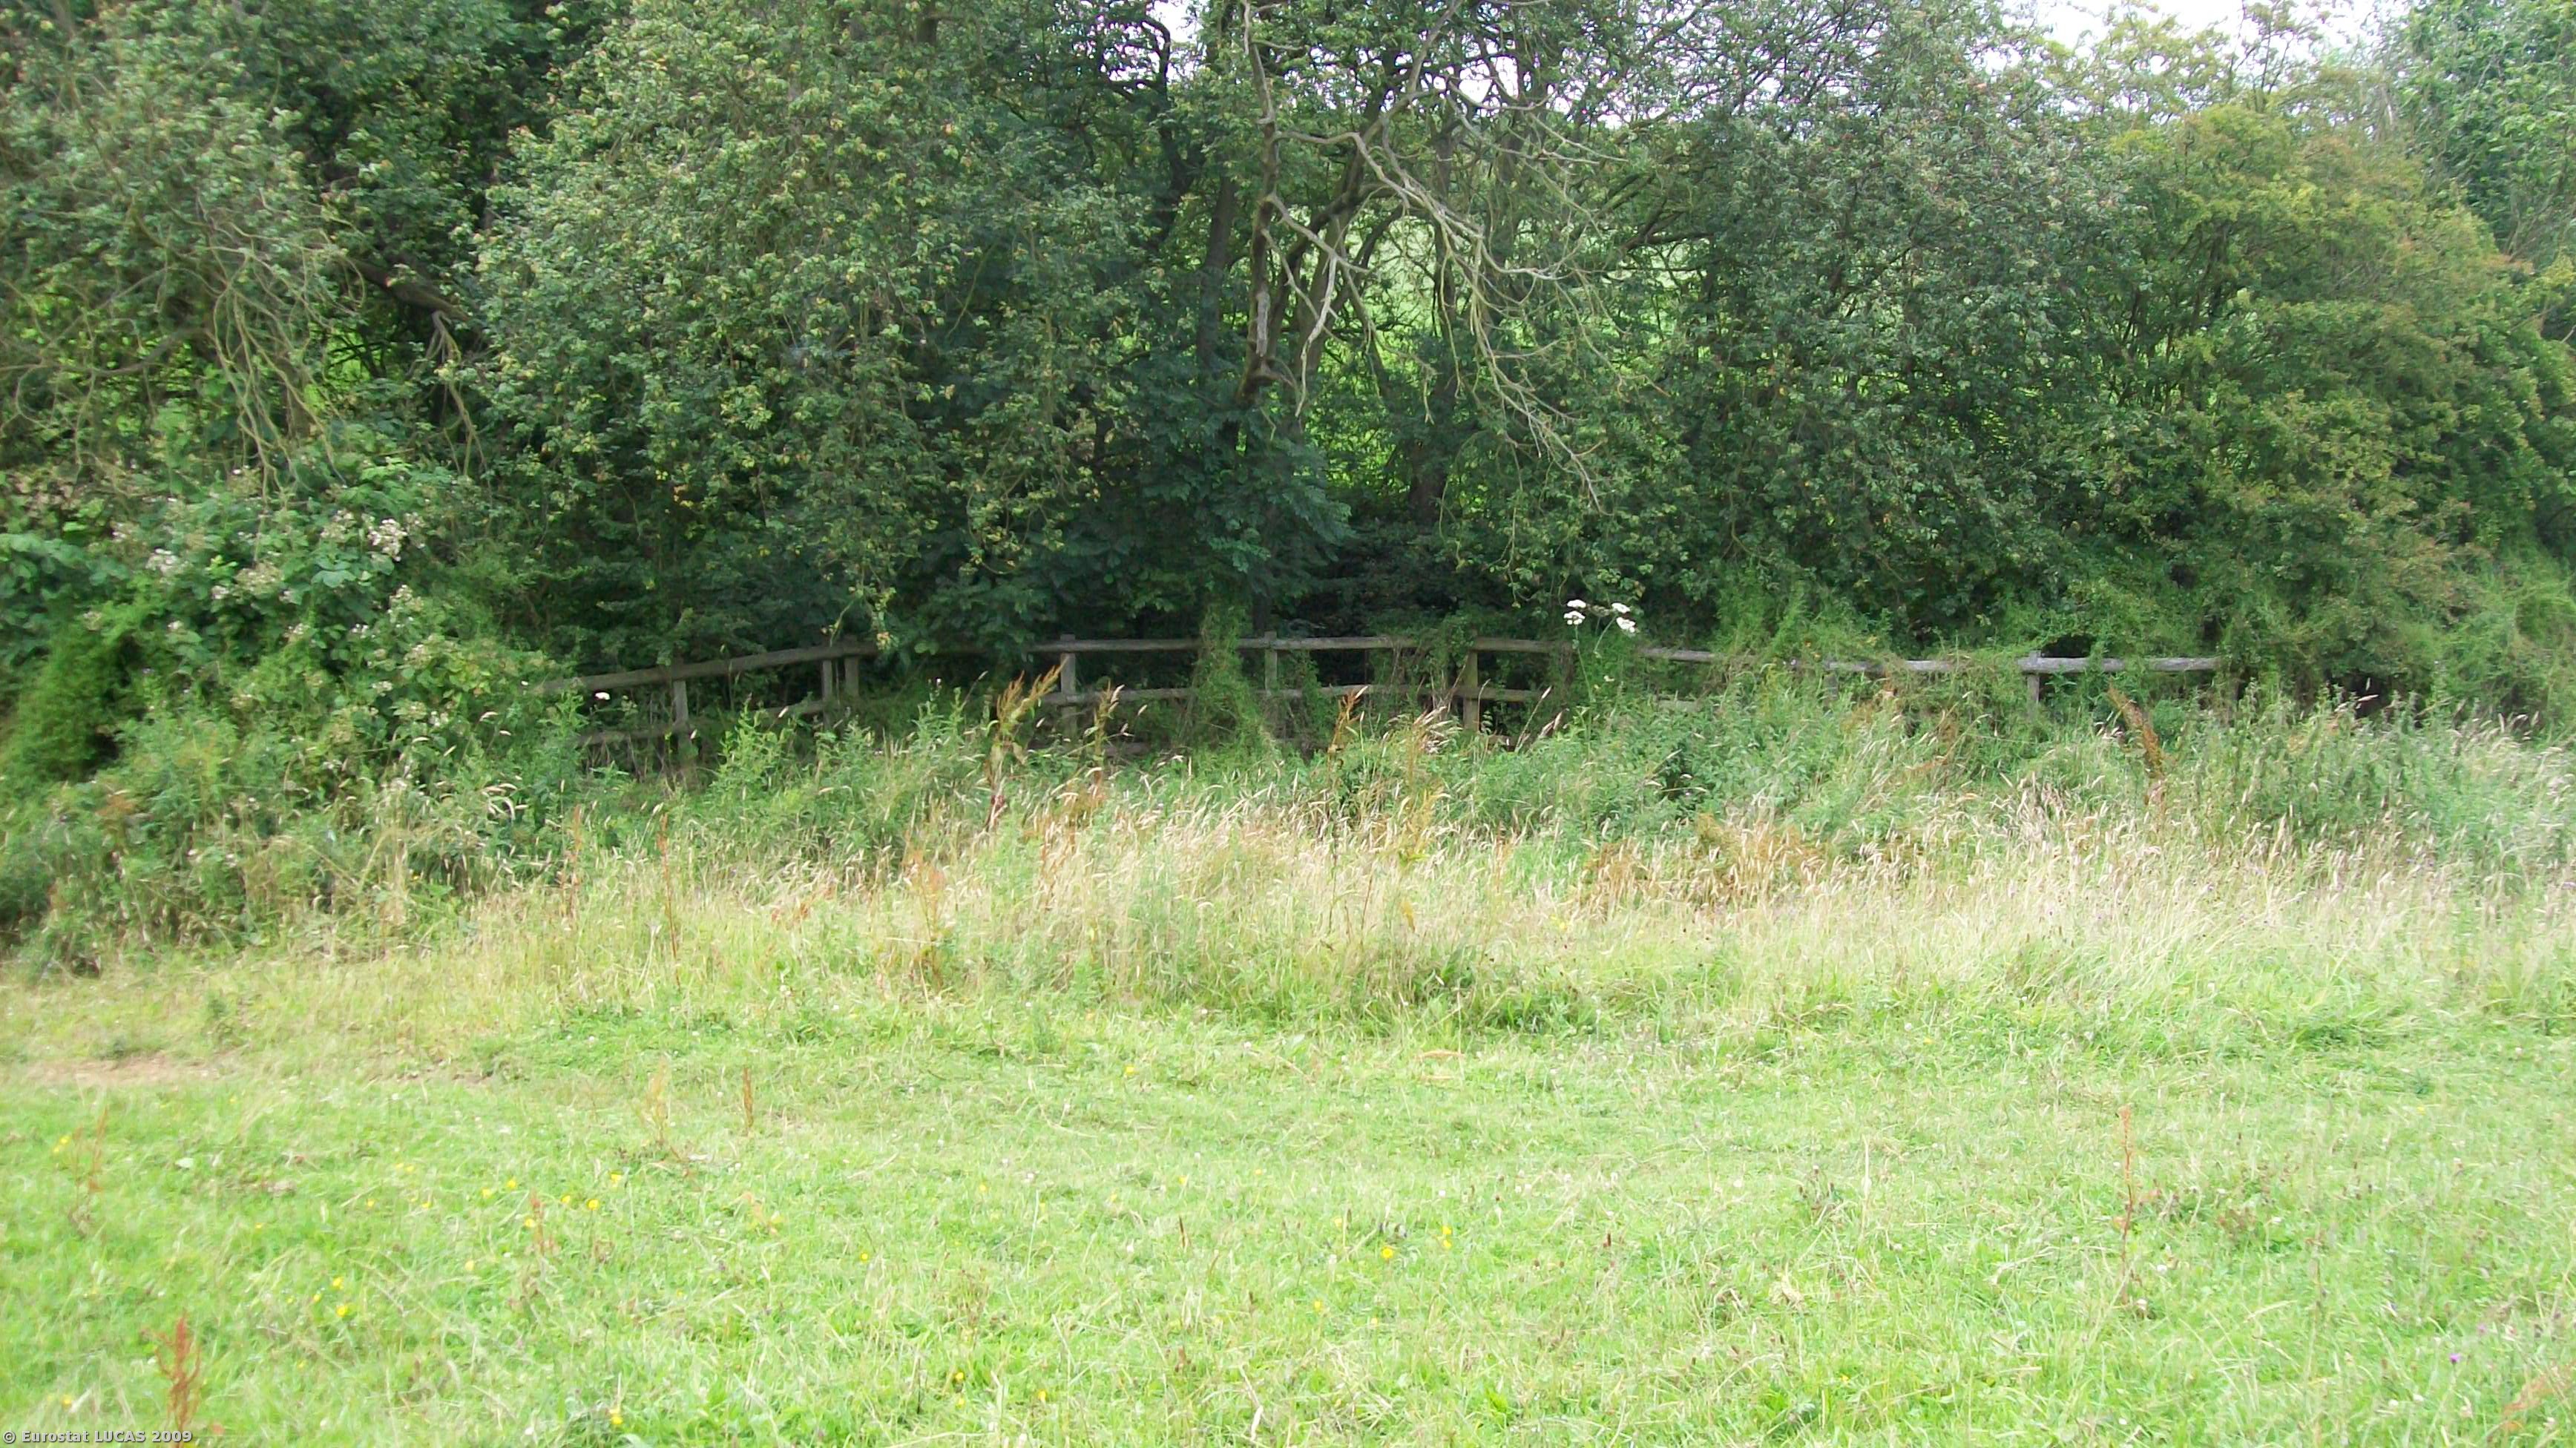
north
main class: Grassland
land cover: Grassland without tree/shrub cover
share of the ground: > 75 %
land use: Agriculture (excluding fallow land and kitchen gardens)
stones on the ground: < 10 %
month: July
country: GB
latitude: 53.1458
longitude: -1.2756
